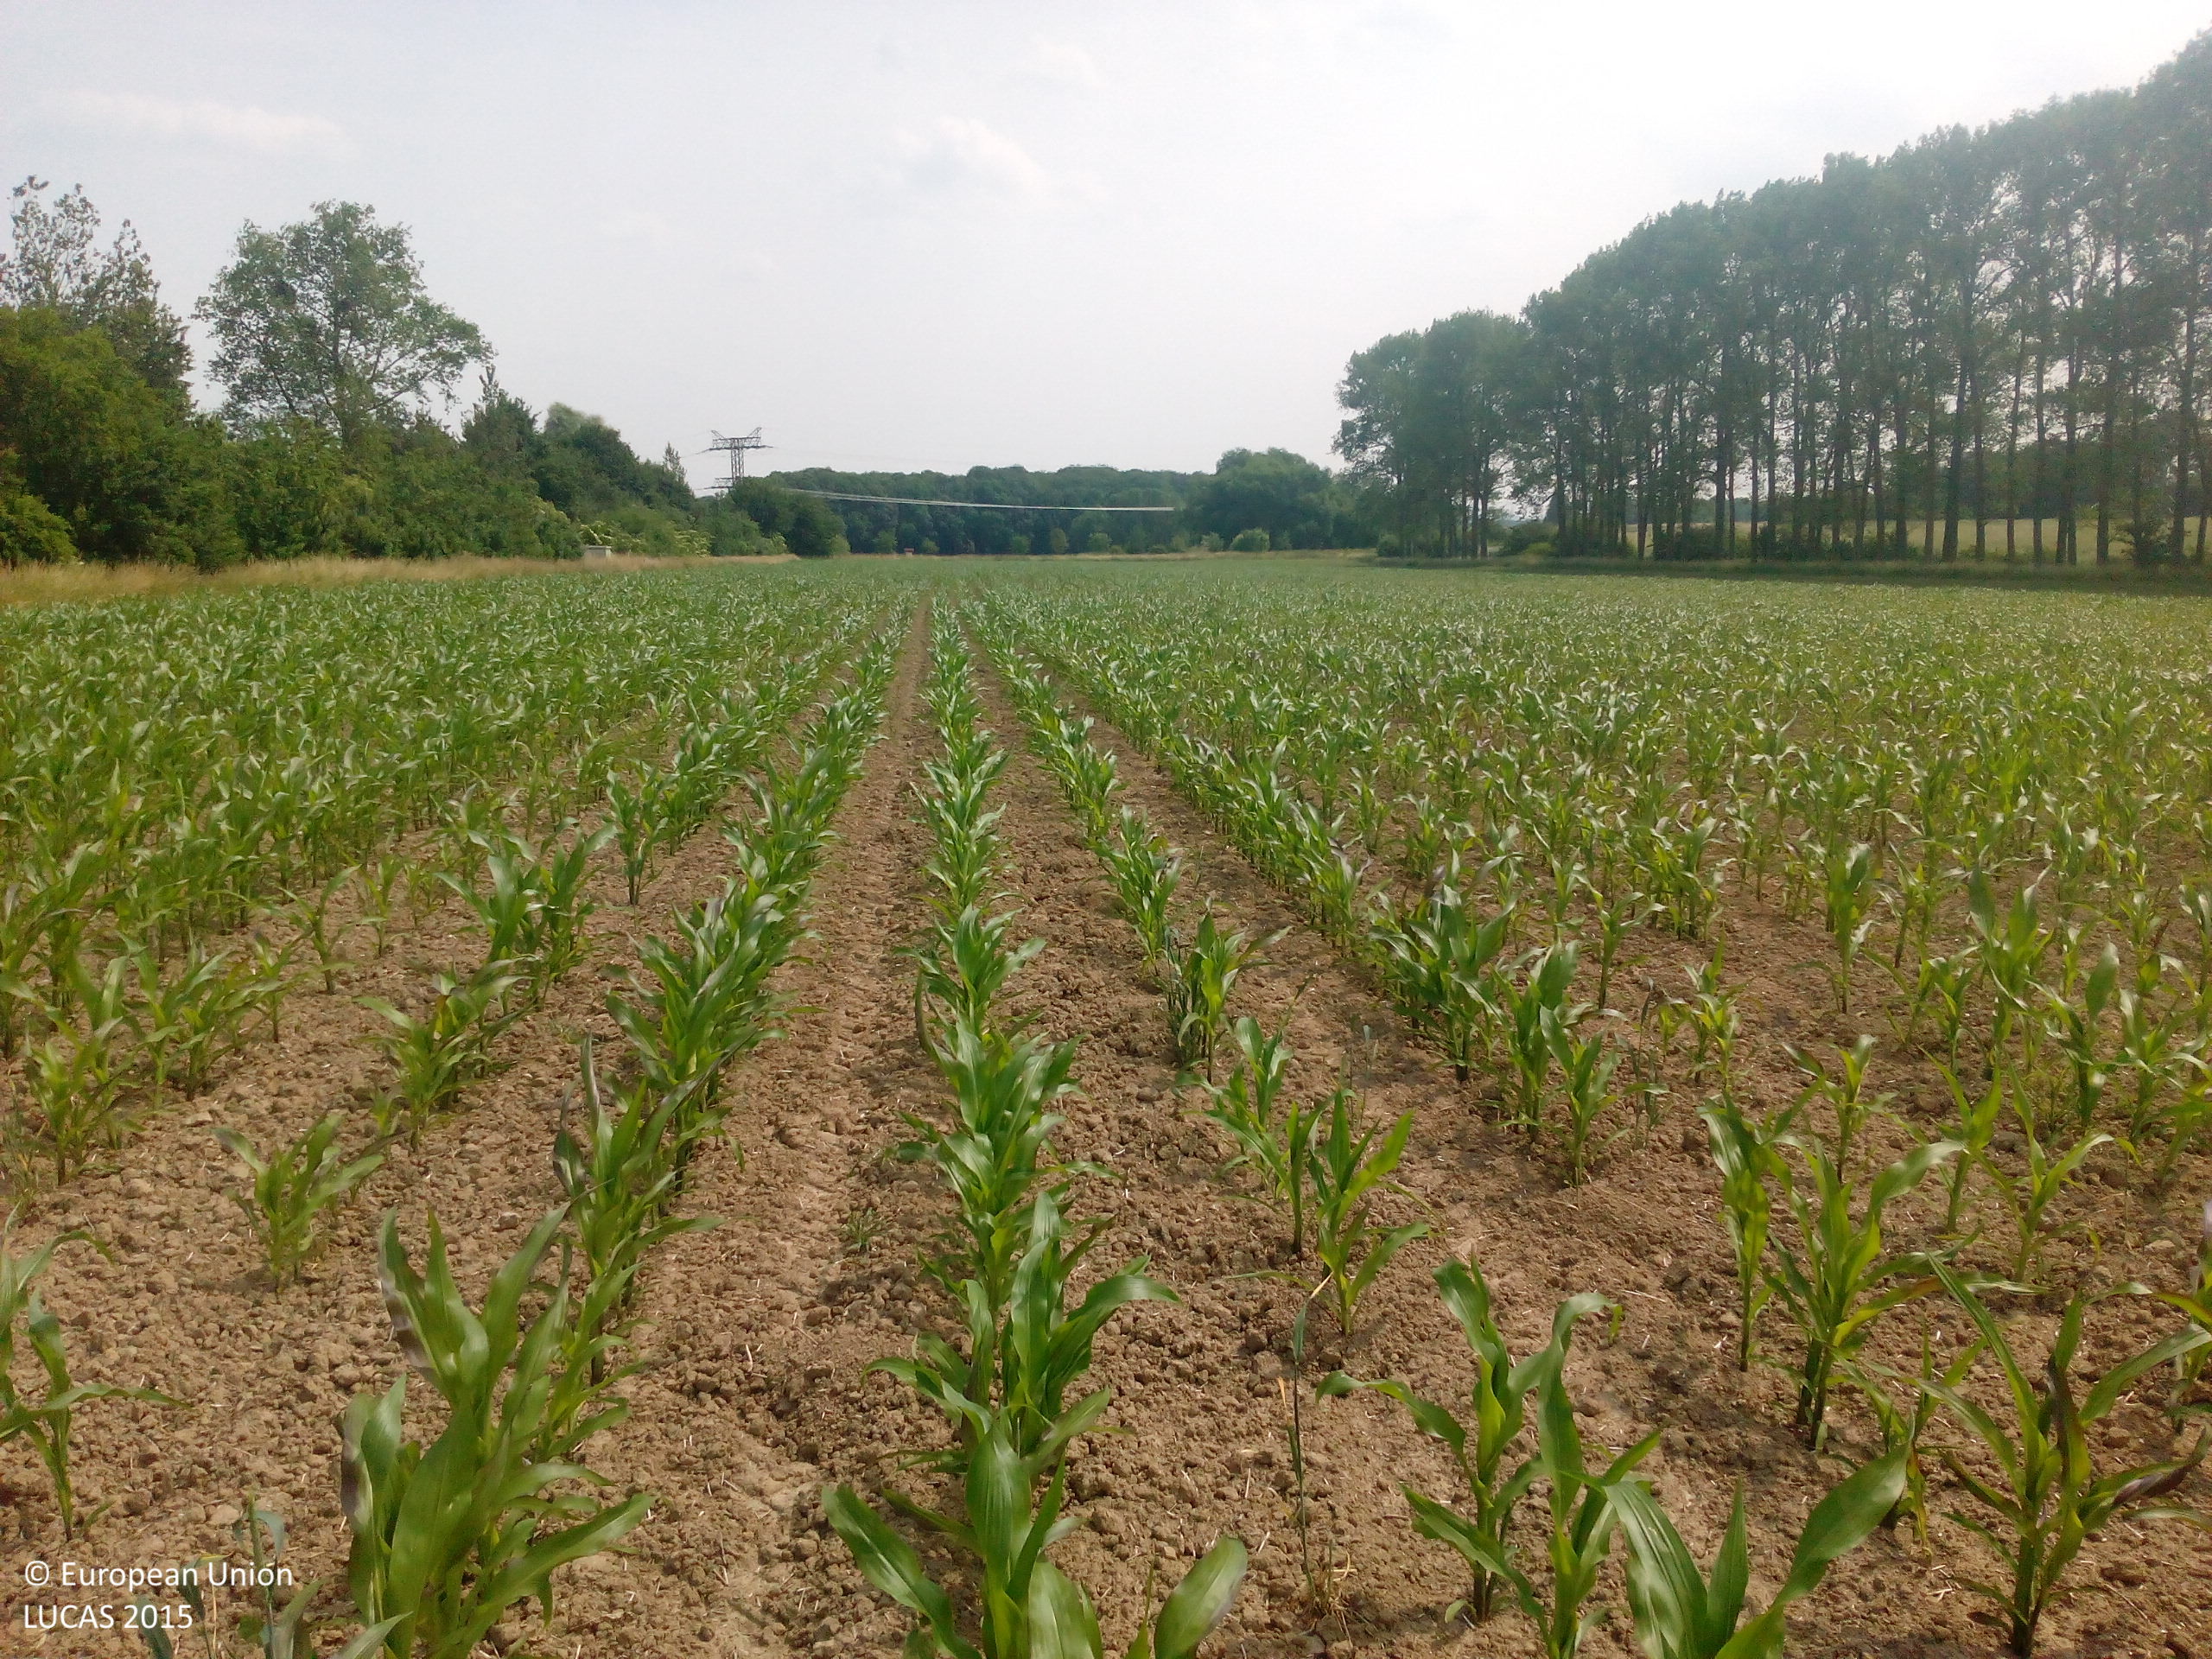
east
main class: Cropland
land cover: Maize
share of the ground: 25 - 50 %
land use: Agriculture (excluding fallow land and kitchen gardens)
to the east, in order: Maize
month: June
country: DE
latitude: 52.1744
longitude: 11.1256
